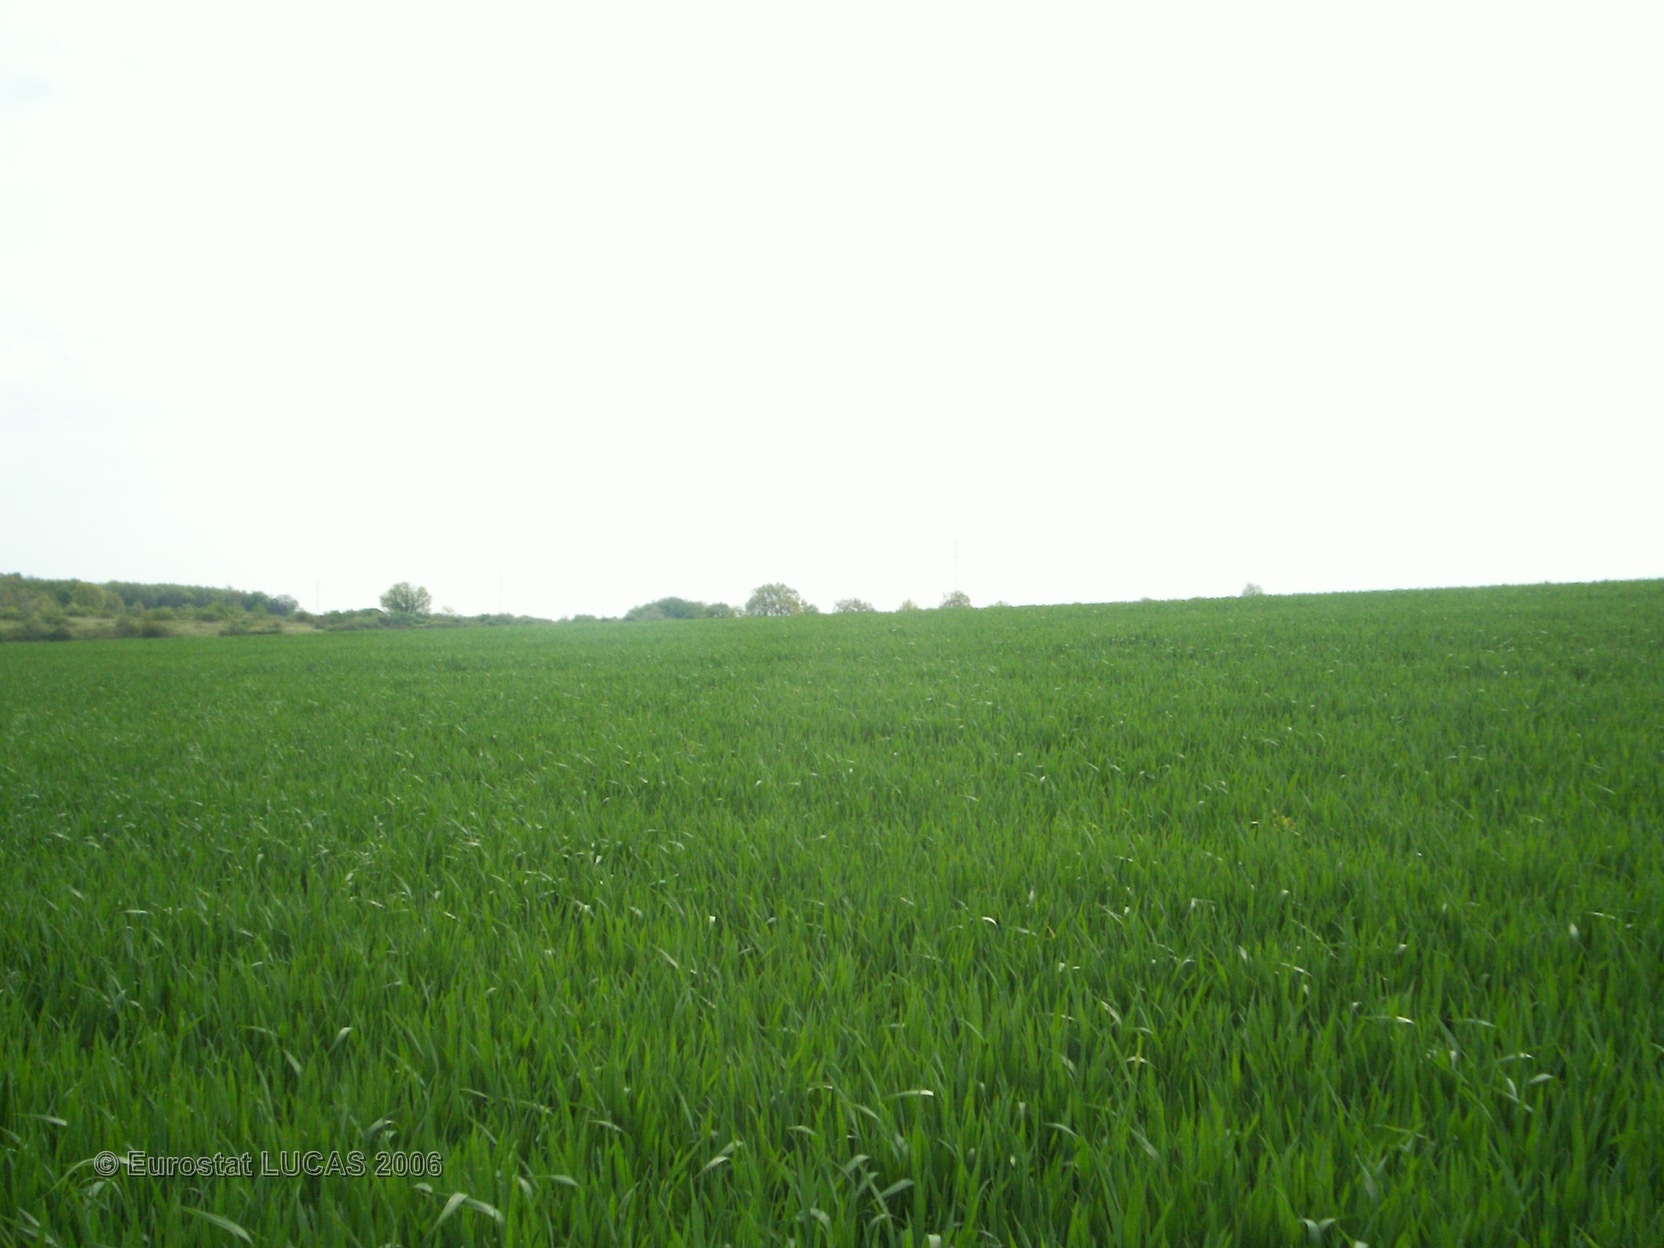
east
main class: Cropland
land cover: Common wheat
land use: Agriculture (excluding fallow land and kitchen gardens)
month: May
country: FR
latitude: 46.2441
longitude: 3.2156
